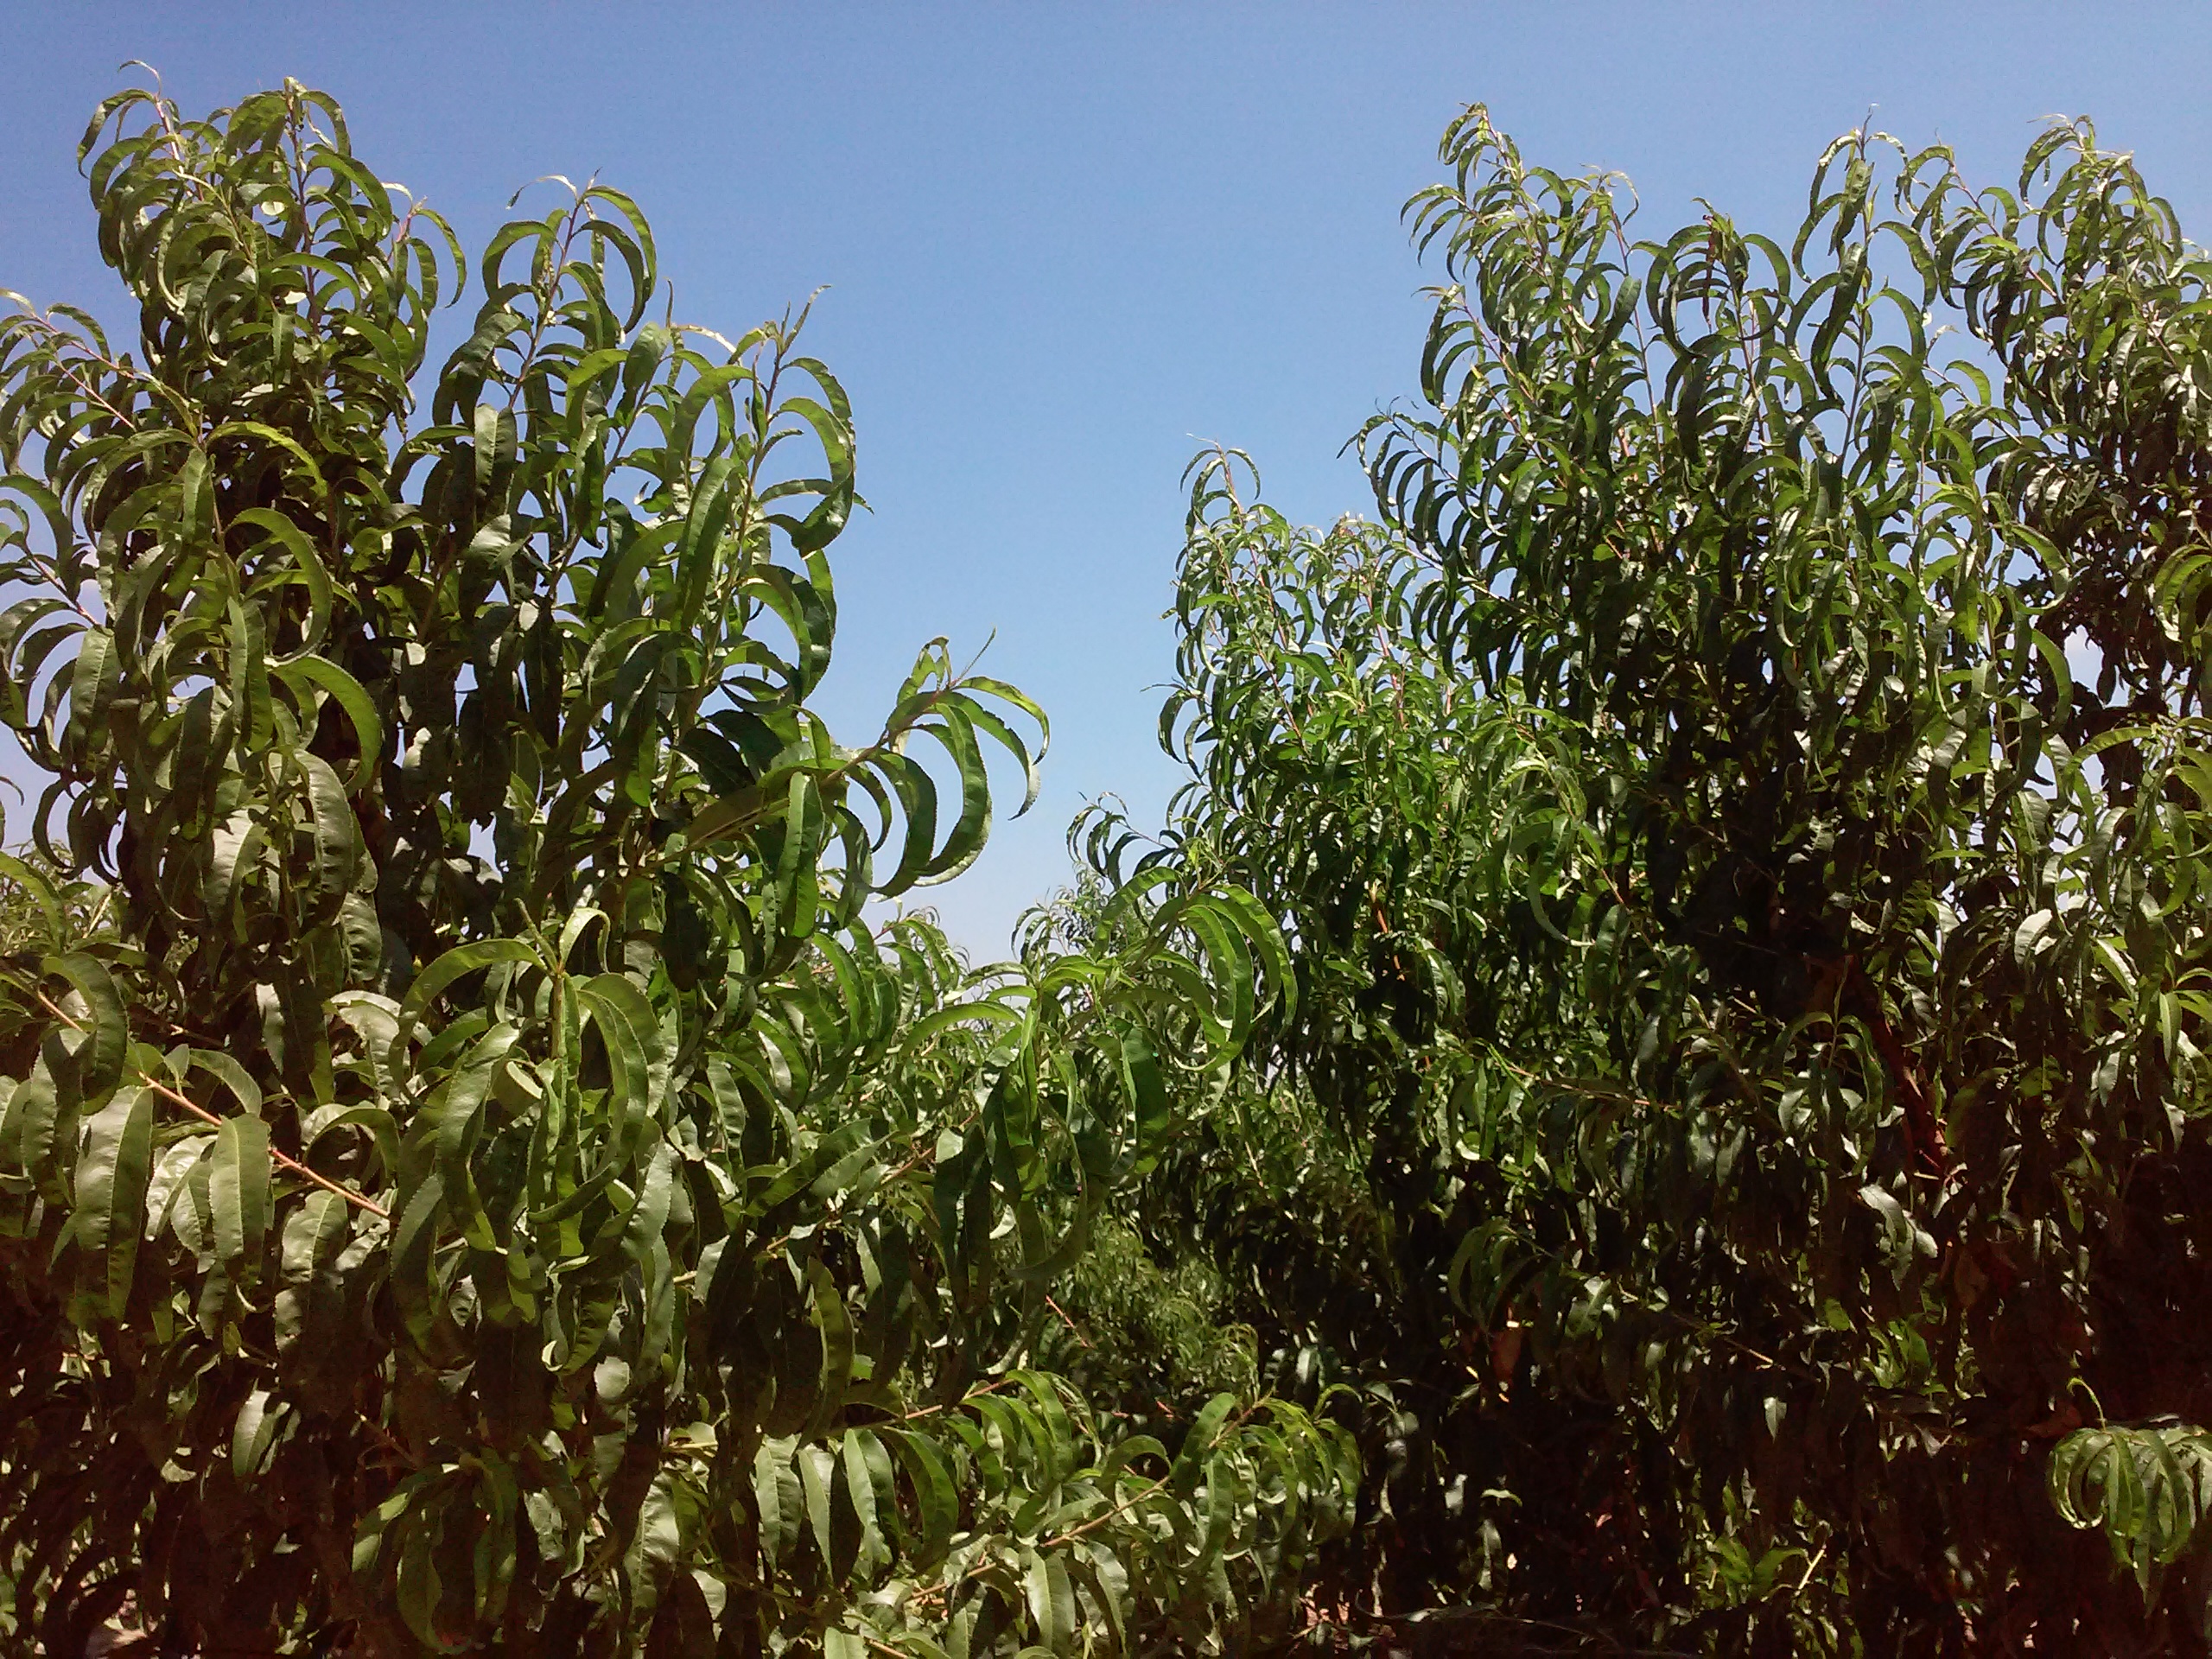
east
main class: Cropland
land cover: Other fruit trees and berries
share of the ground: 50 - 75 %
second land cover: Grassland without tree/shrub cover
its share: > 75 %
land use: Agriculture (excluding fallow land and kitchen gardens)
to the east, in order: Other fruit trees and berries; Grassland without tree/shrub cover; Paved roads, cycling and walking lanes; Shrubland with sparse tree cover; Tracks; Other fruit trees and berries
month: July
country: ES
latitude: 41.6467
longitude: 0.5378
